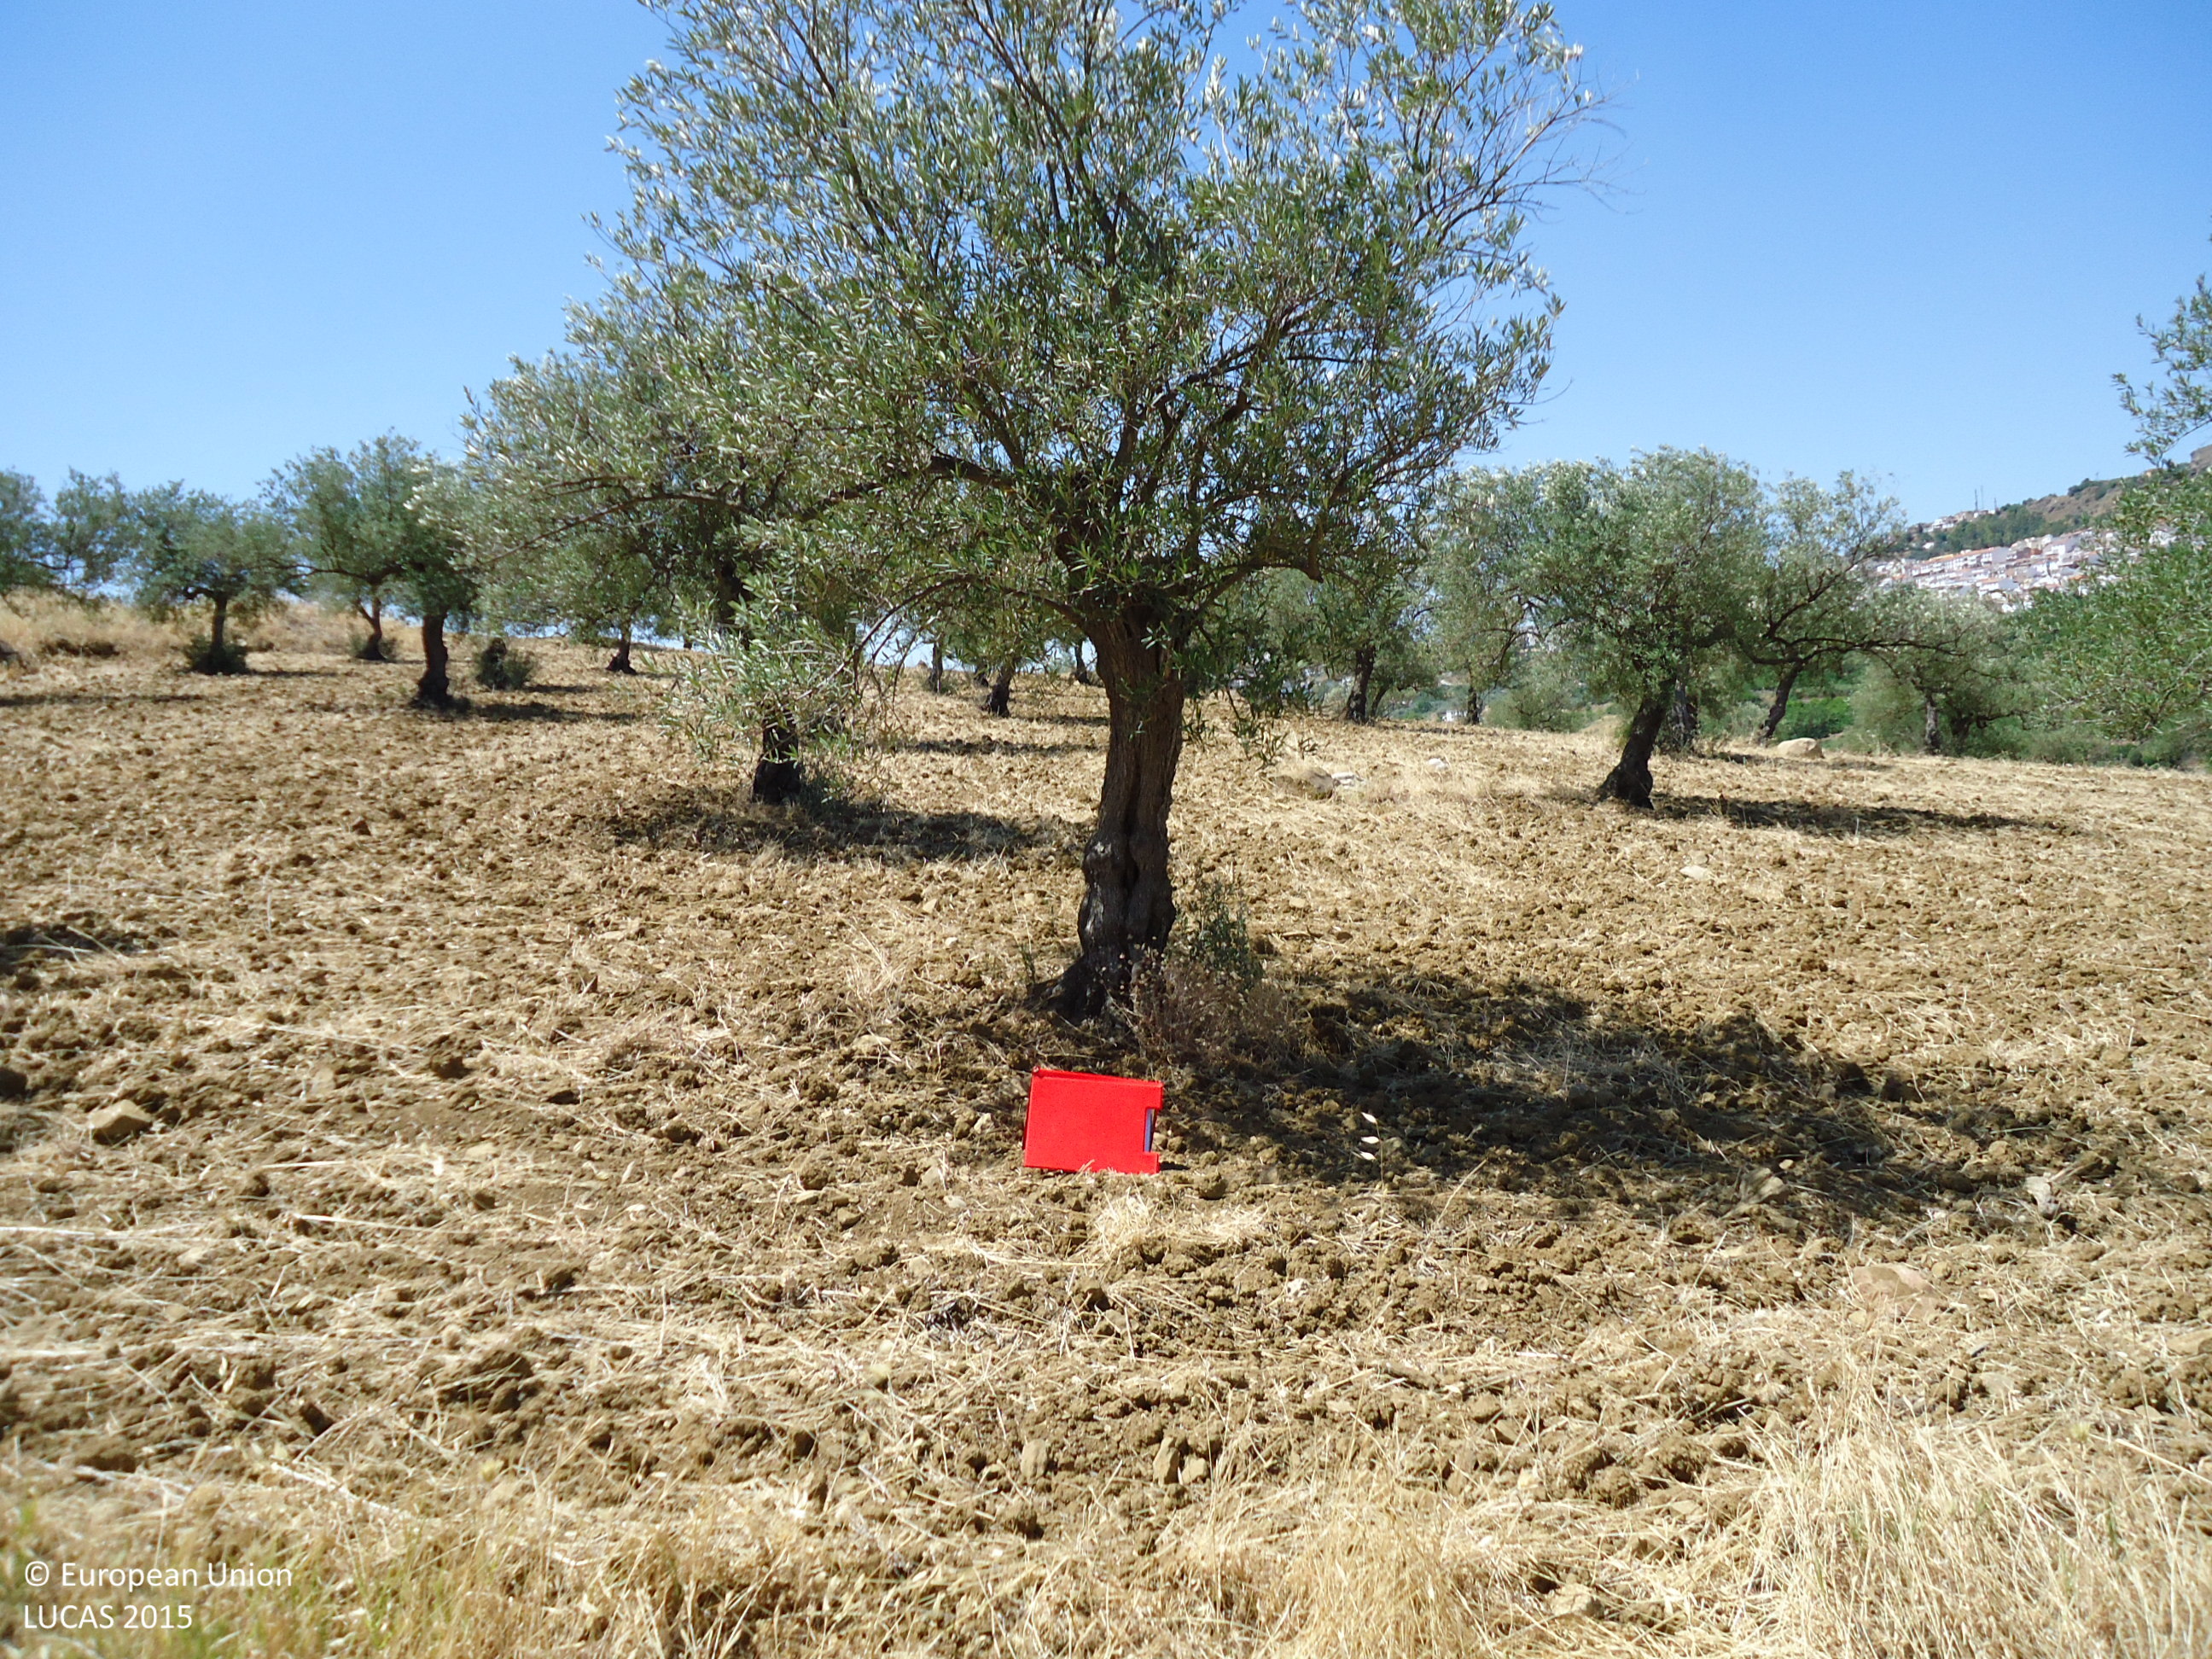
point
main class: Cropland
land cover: Olive groves
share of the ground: 25 - 50 %
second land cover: Other bare soil
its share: > 75 %
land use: Agriculture (excluding fallow land and kitchen gardens)
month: June
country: ES
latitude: 36.8383
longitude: -4.6957
